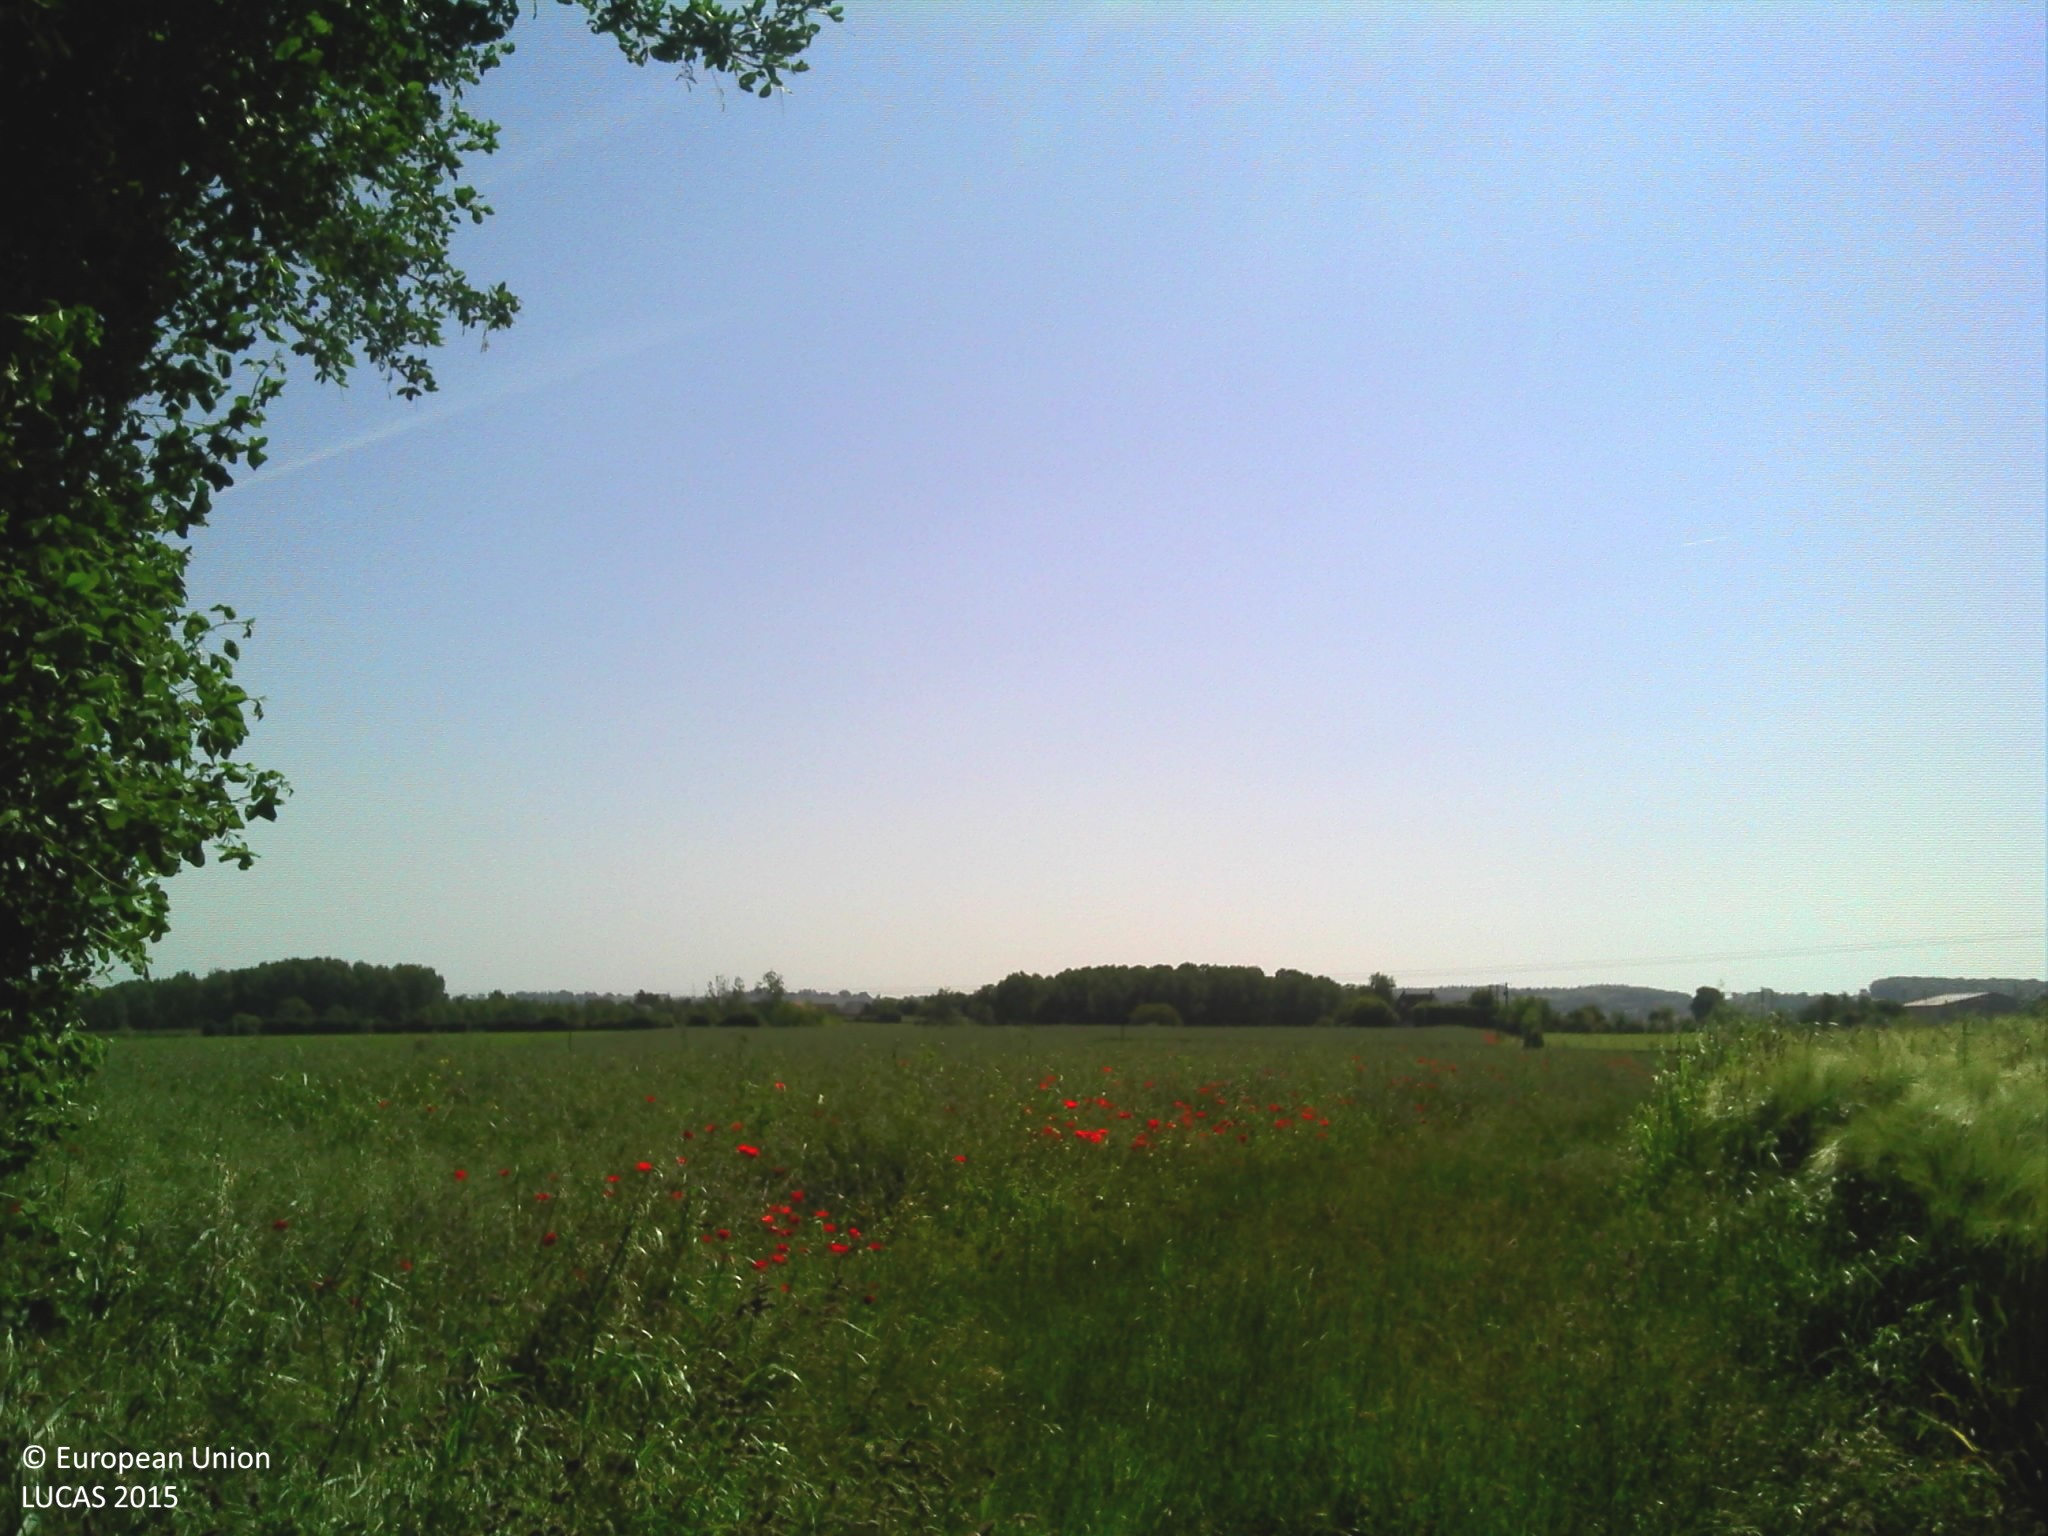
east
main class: Cropland
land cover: Barley
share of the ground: > 75 %
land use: Agriculture (excluding fallow land and kitchen gardens)
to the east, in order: Barley; Managed hedges; Rape and turnip rape
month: June
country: FR
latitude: 48.1471
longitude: -0.0151
